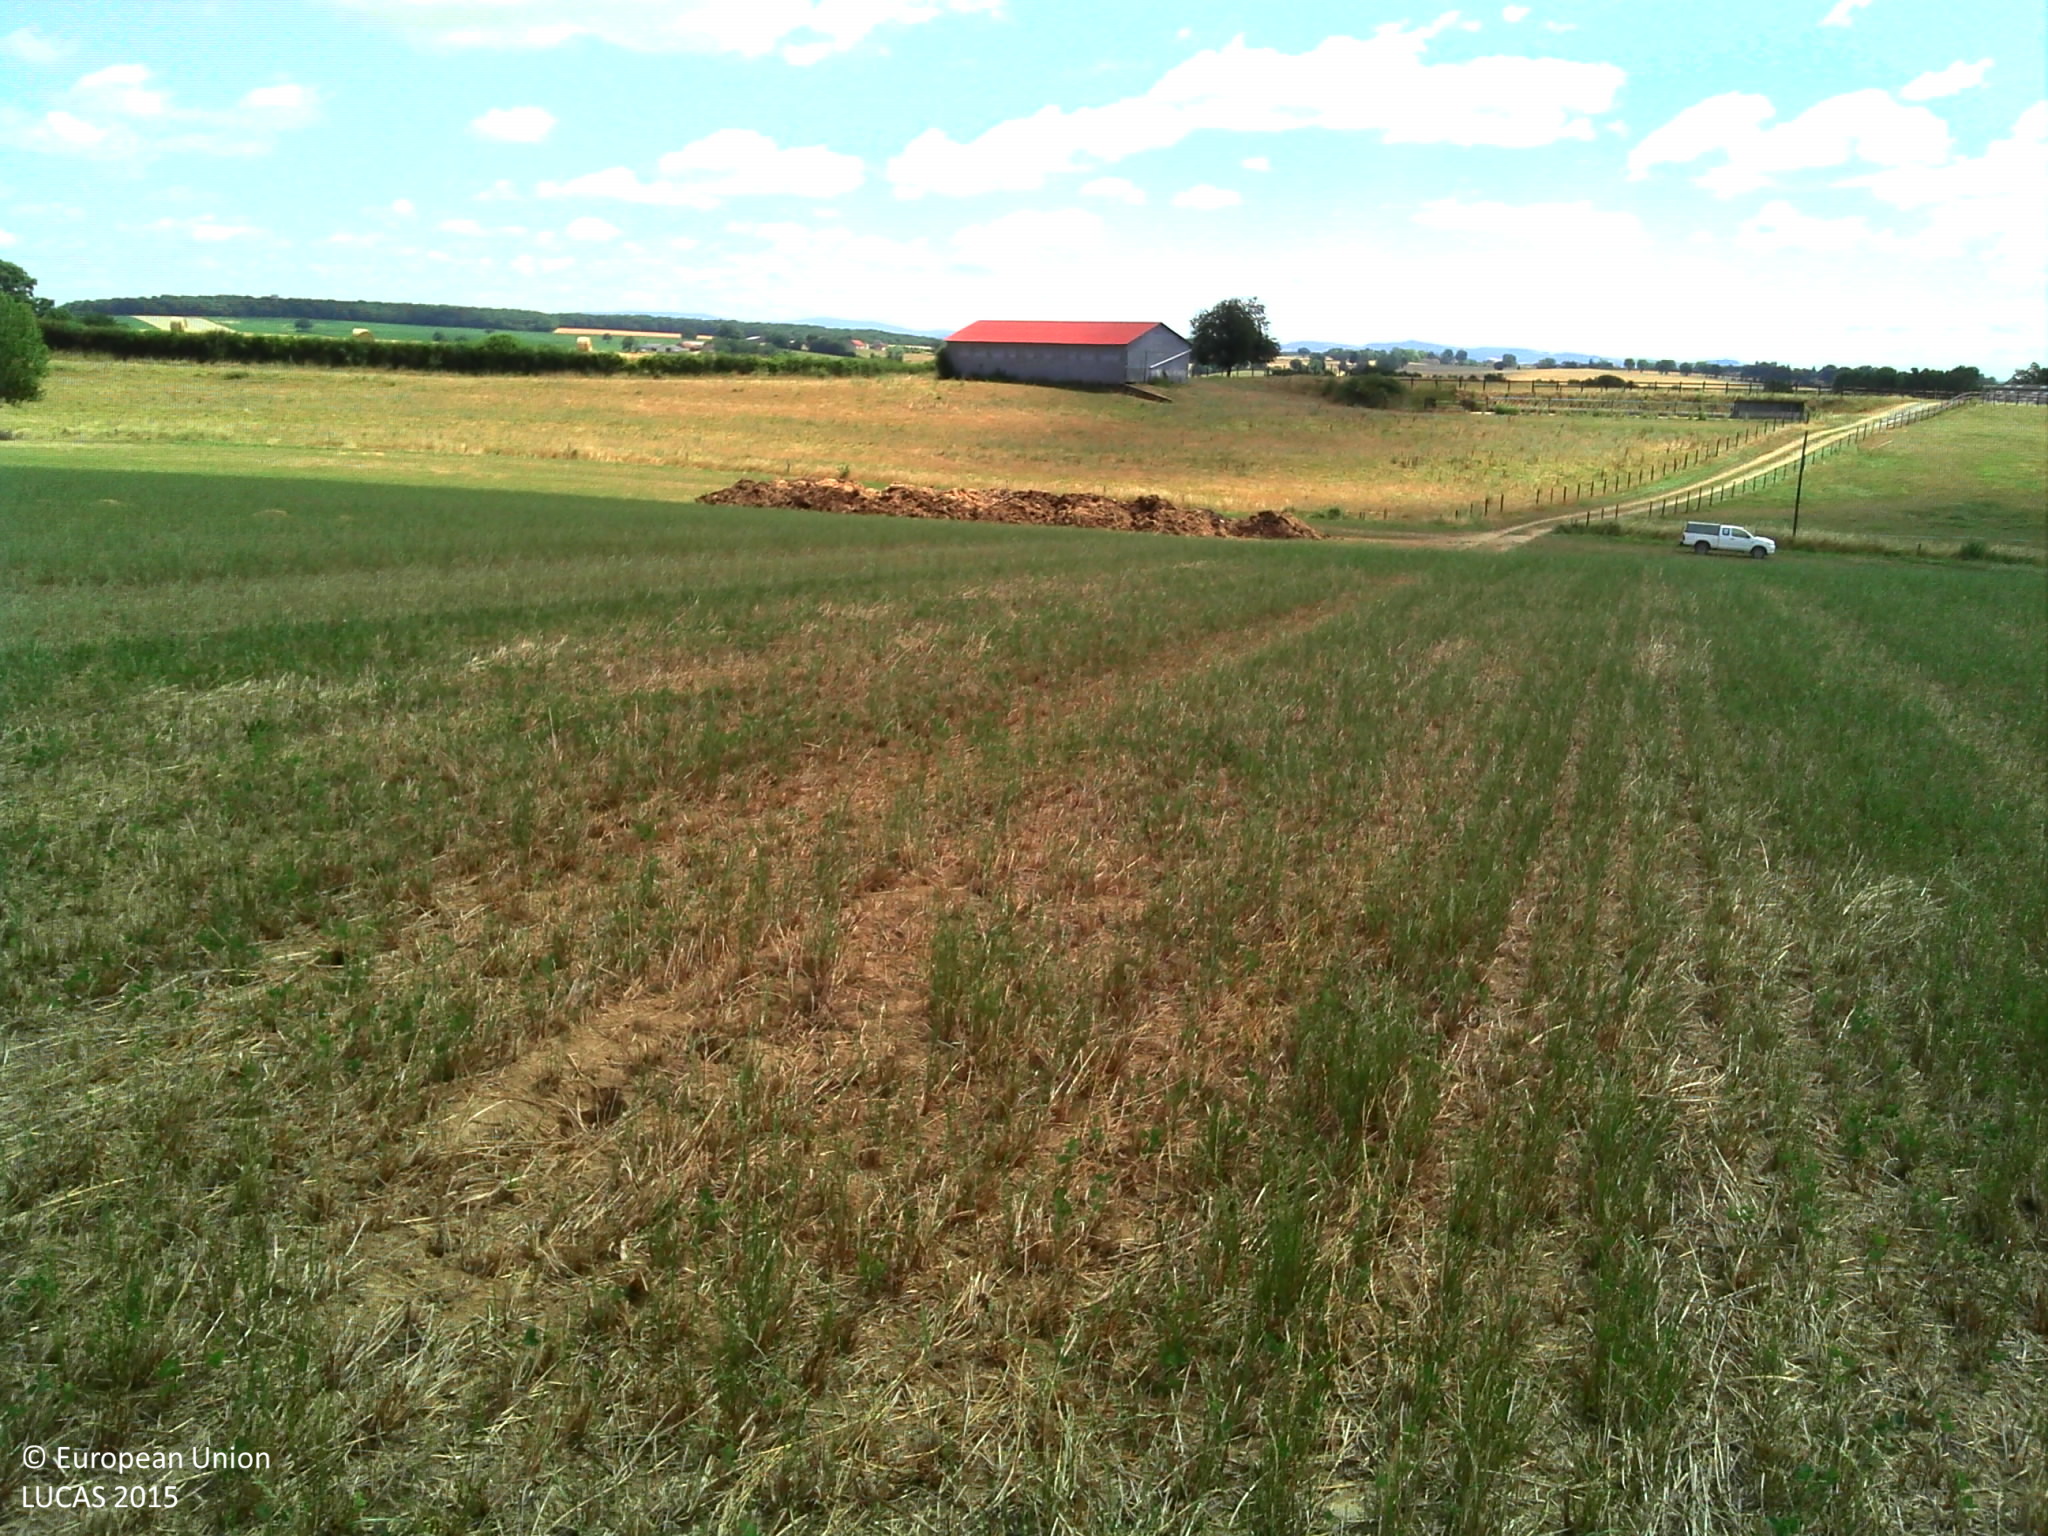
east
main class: Cropland
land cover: Mixed cereals for fodder
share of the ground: > 75 %
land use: Agriculture (excluding fallow land and kitchen gardens)
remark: Harvested field
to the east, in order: Mixed cereals for fodder; Fences; Ditches and canals; Grassland without tree/shrub cover; Fences; Grassland without tree/shrub cover; Single bushes/trees
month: July
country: FR
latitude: 46.9019
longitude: 3.6315
